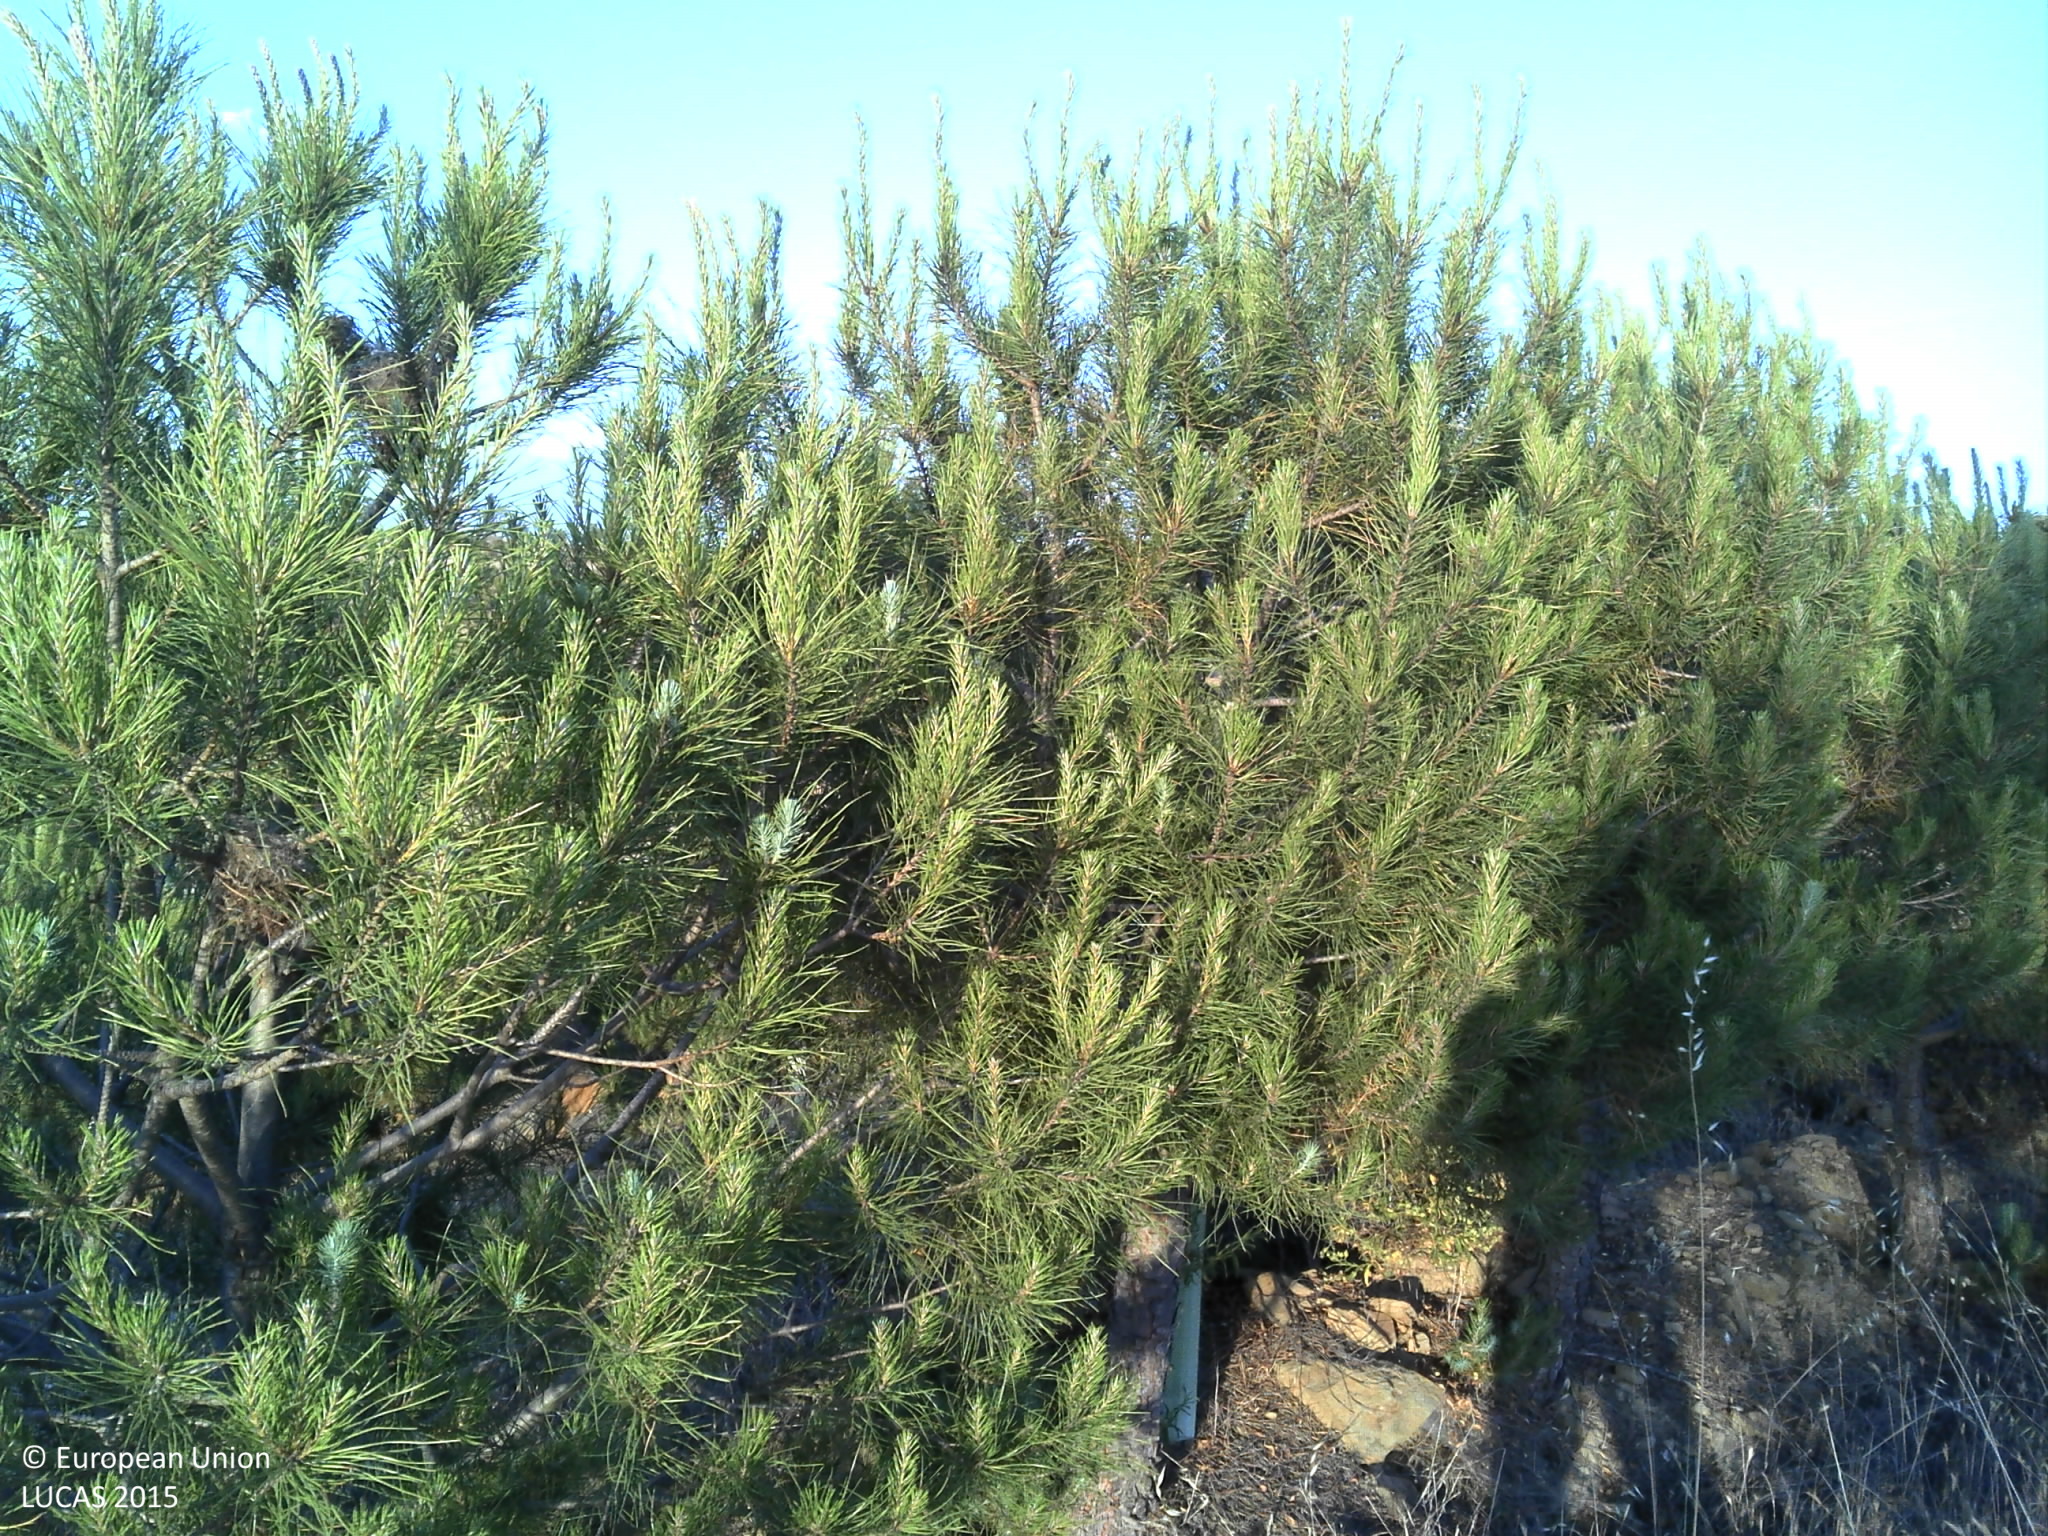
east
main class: Woodland
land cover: Pine dominated coniferous woodland
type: coniferous forest of the mediterranean region
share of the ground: 10 - 25 %
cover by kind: consolidated bare surface 50 %, coniferous forest trees 25 %, herbaceous plants 25 %
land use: Forestry
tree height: < 5 m
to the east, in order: Pine dominated coniferous woodland; Ditches and canals; Pine dominated coniferous woodland
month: May
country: PT
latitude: 37.5039
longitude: -7.7638
